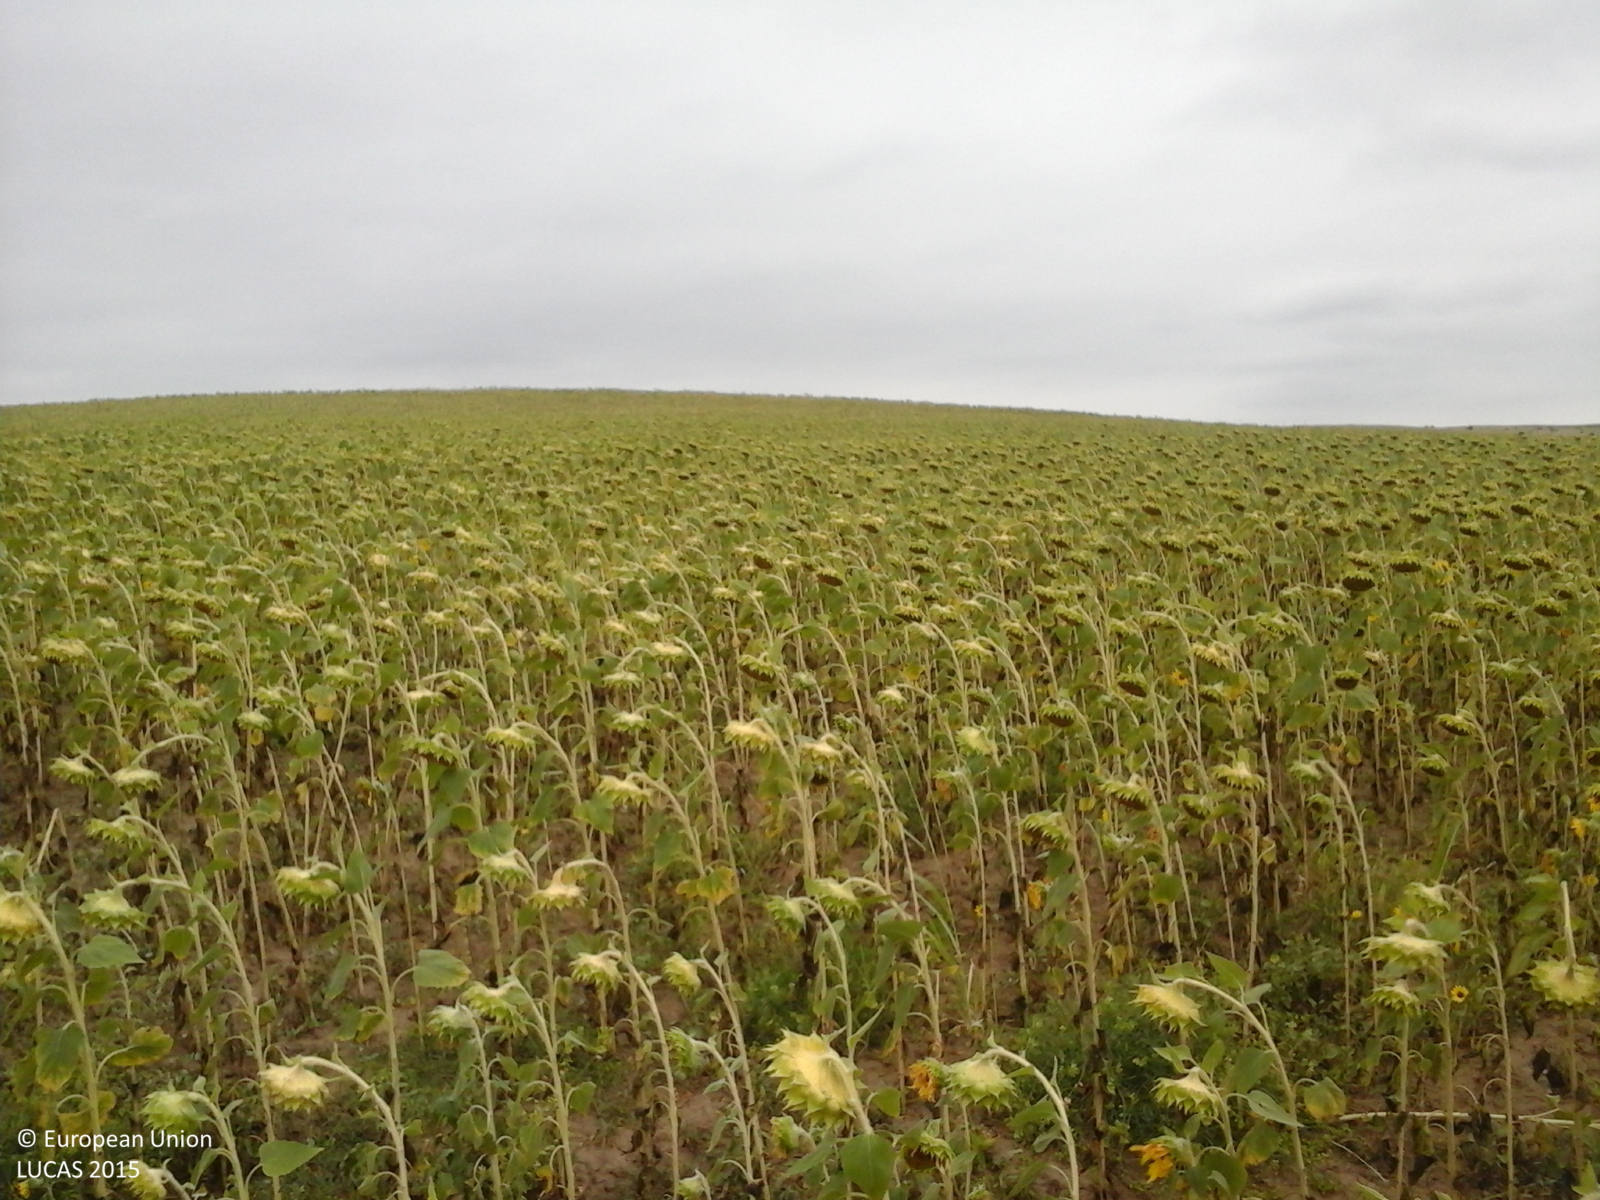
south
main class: Cropland
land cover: Sunflower
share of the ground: > 75 %
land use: Agriculture (excluding fallow land and kitchen gardens)
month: August
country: RO
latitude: 44.9193
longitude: 28.7195
